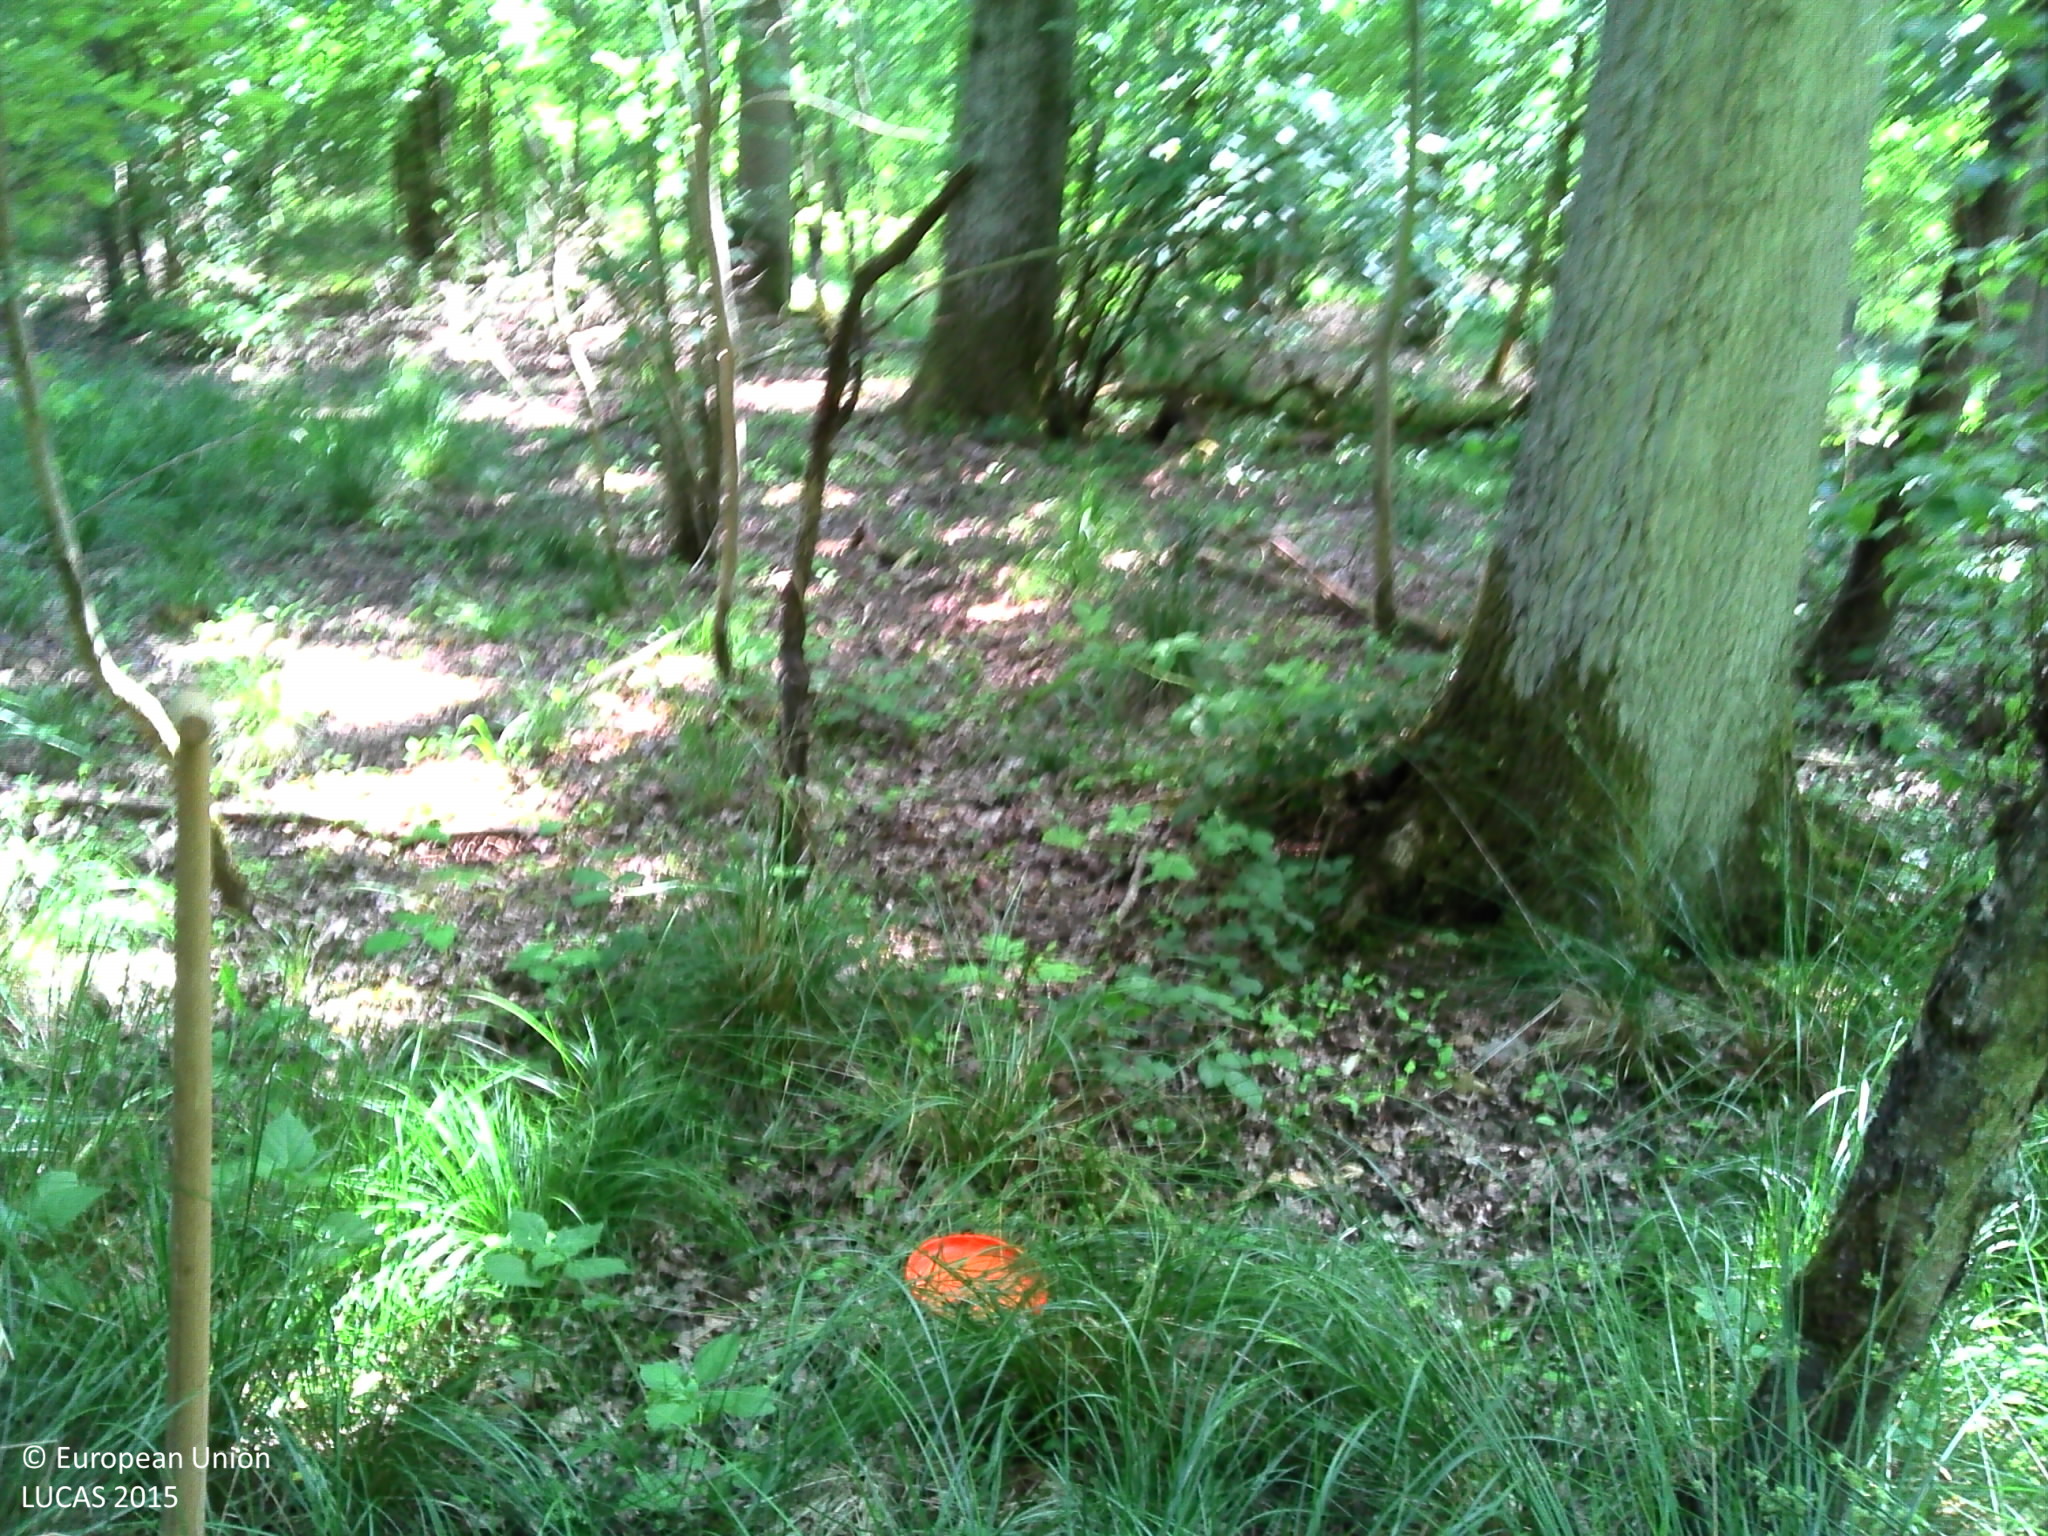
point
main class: Woodland
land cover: Broadleaved woodland
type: mesophytic deciduous forest
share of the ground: > 75 %
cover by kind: broadleaved forest trees 80 %, herbaceous plants 10 %
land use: Forestry
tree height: > 5 m
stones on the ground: < 10 %
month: June
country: FR
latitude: 50.7595
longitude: 2.3738
